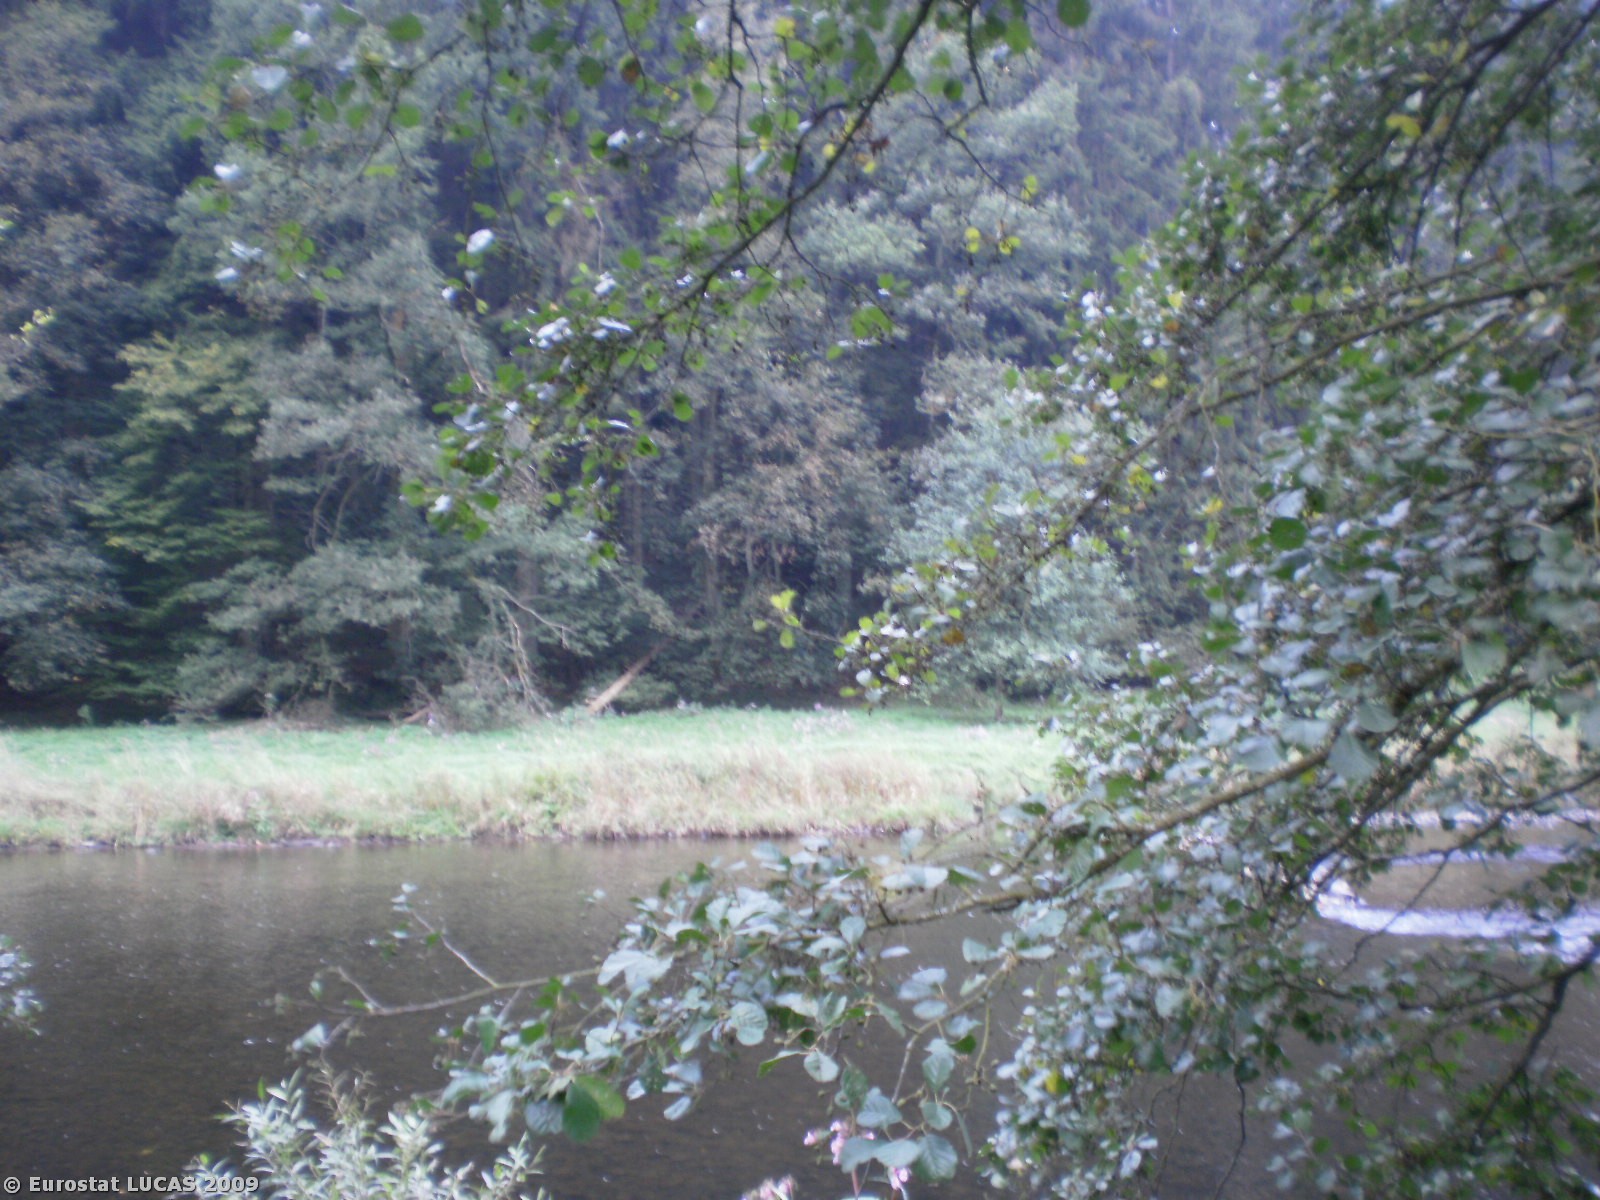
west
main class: Woodland
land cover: Broadleaved woodland
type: mountainous beech forest
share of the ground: > 75 %
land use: Forestry
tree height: > 5 m
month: September
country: BE
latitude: 50.1720
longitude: 5.6161
